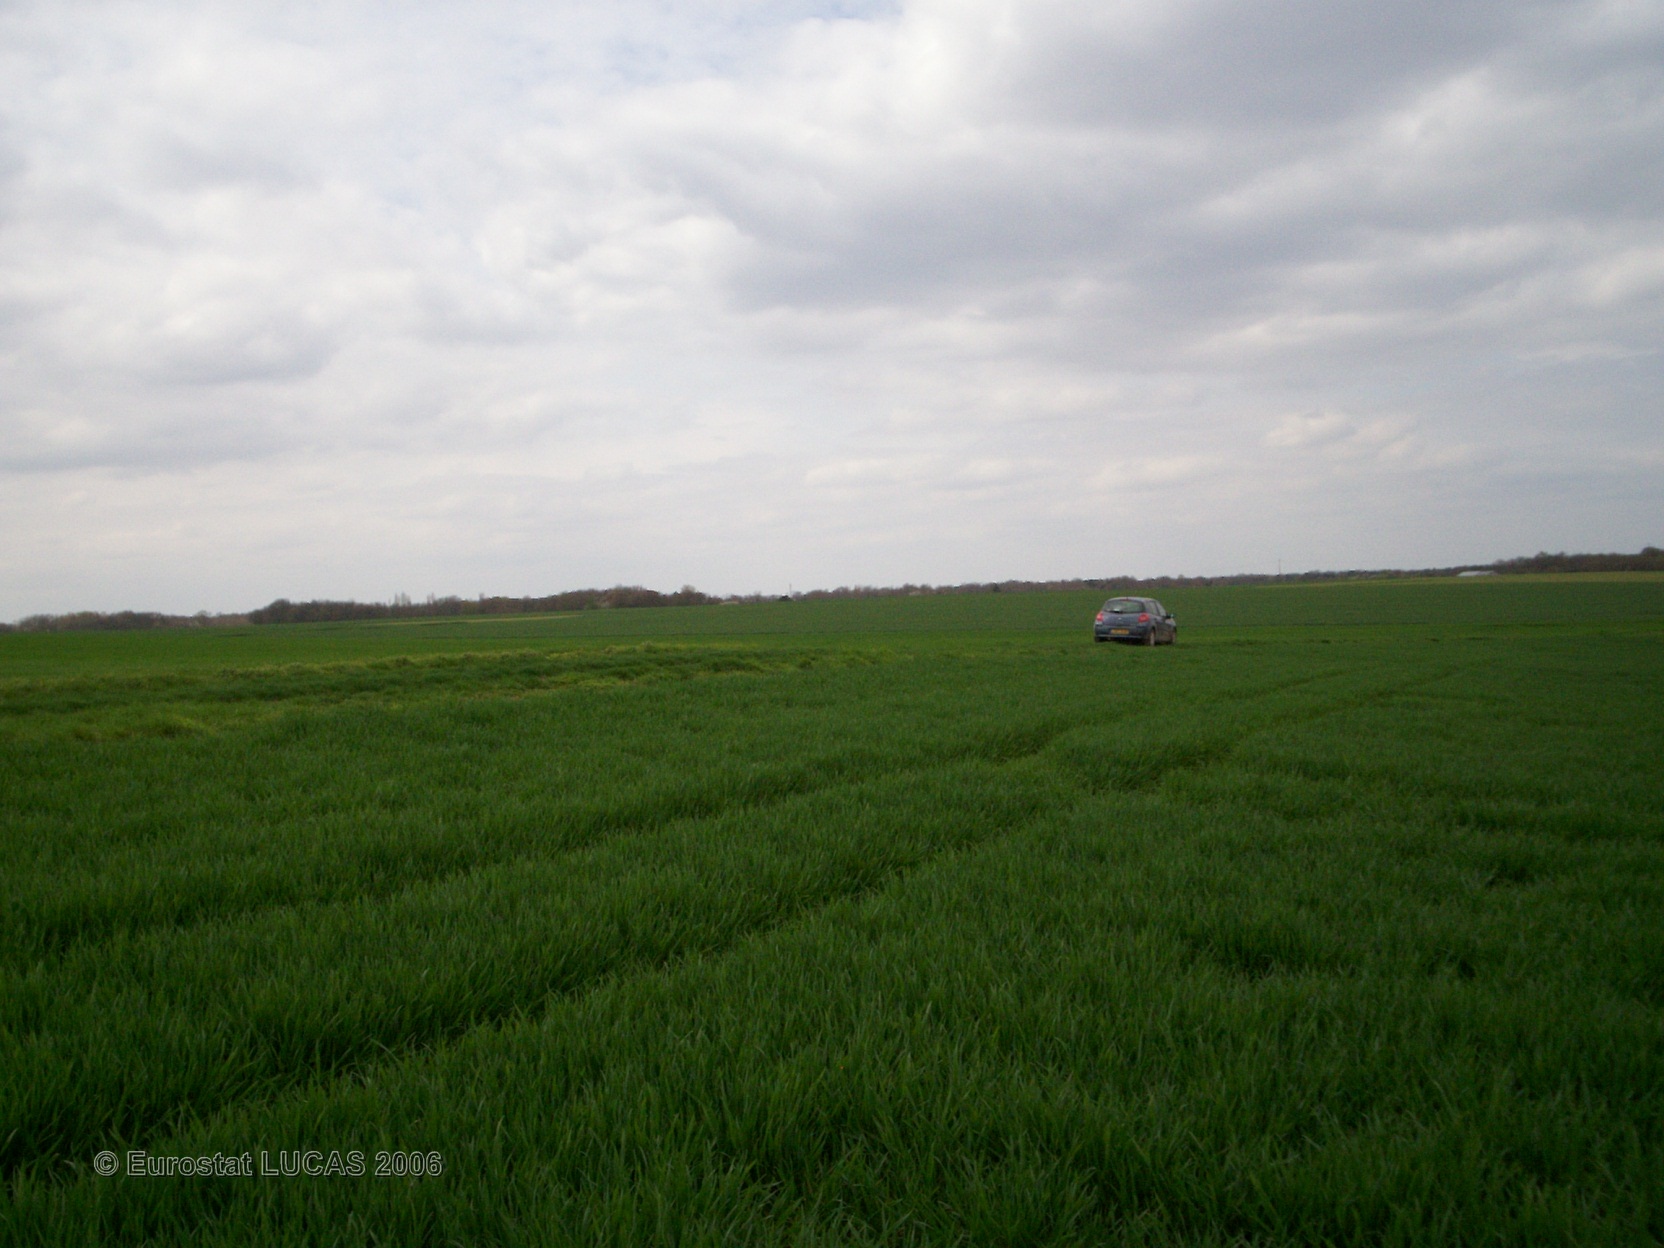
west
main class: Cropland
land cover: Common wheat
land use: Agriculture (excluding fallow land and kitchen gardens)
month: April
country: FR
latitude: 48.2436
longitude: 2.8412
